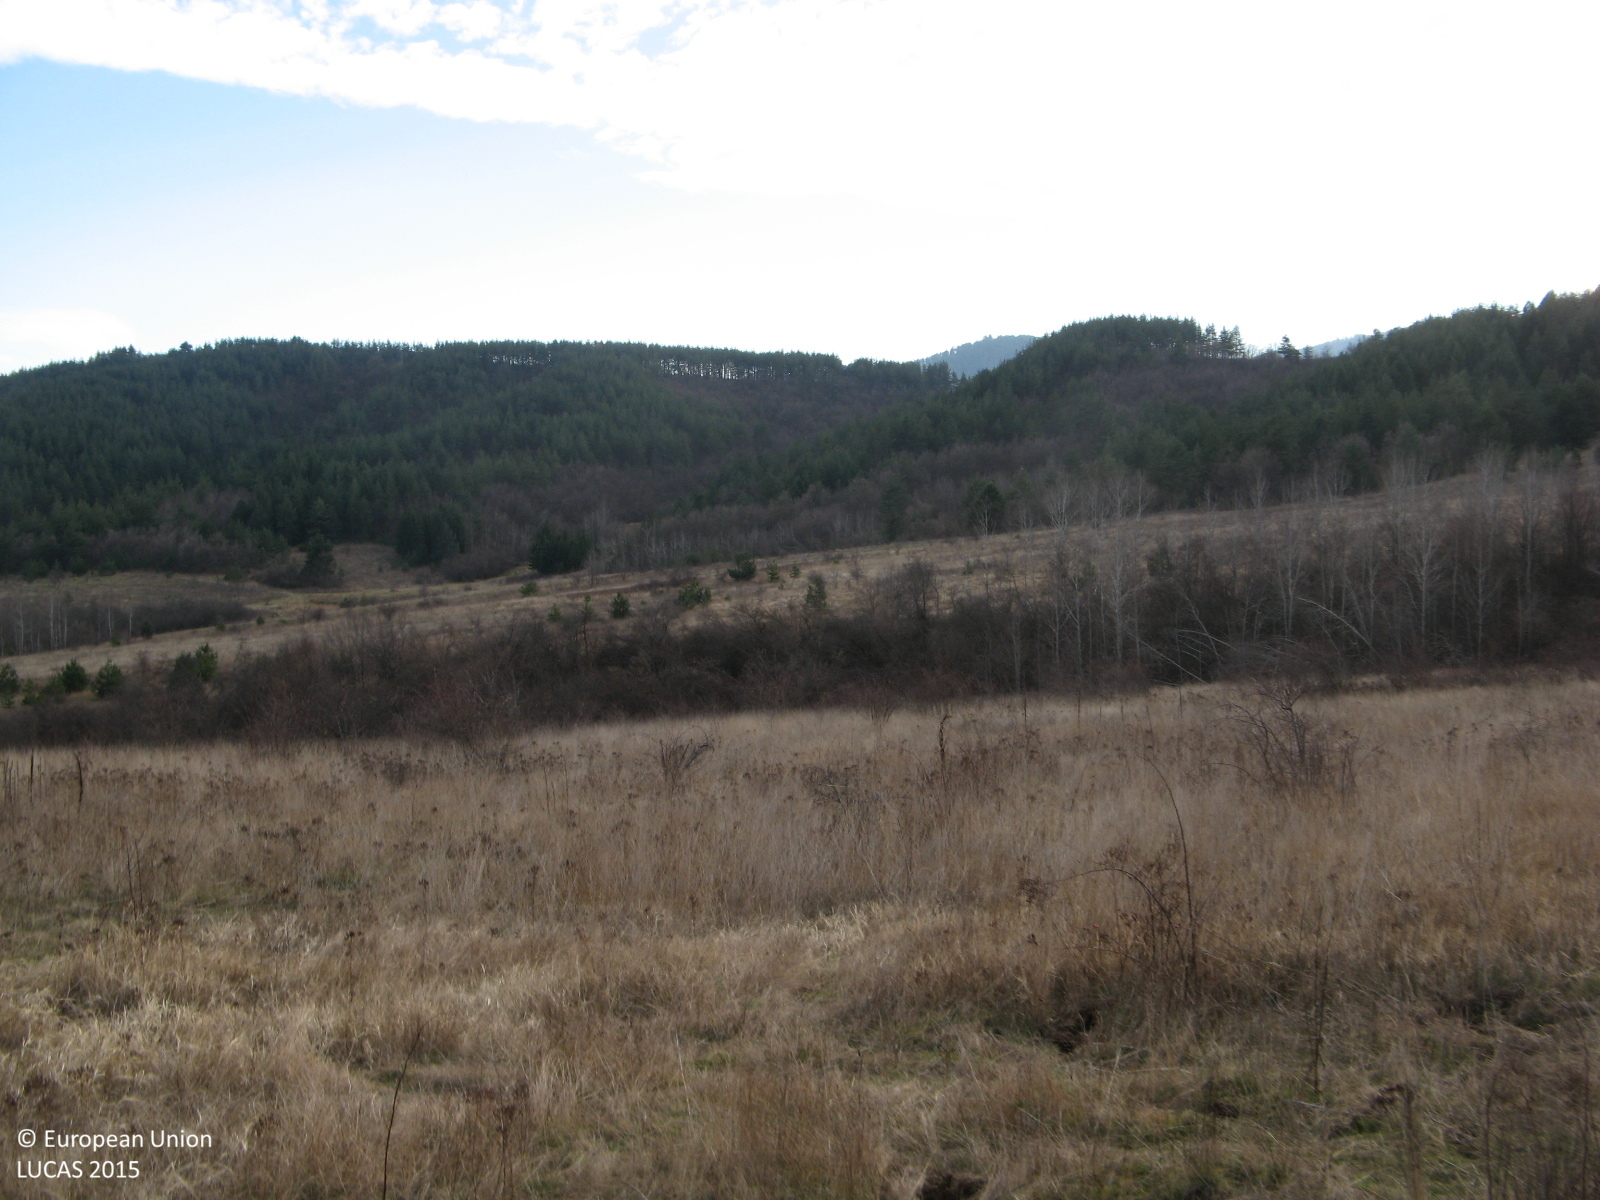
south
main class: Grassland
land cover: Grassland without tree/shrub cover
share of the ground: > 75 %
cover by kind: herbaceous plants 100 %
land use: Agriculture (excluding fallow land and kitchen gardens)
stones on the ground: < 10 %
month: December
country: BG
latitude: 42.0158
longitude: 24.0582
